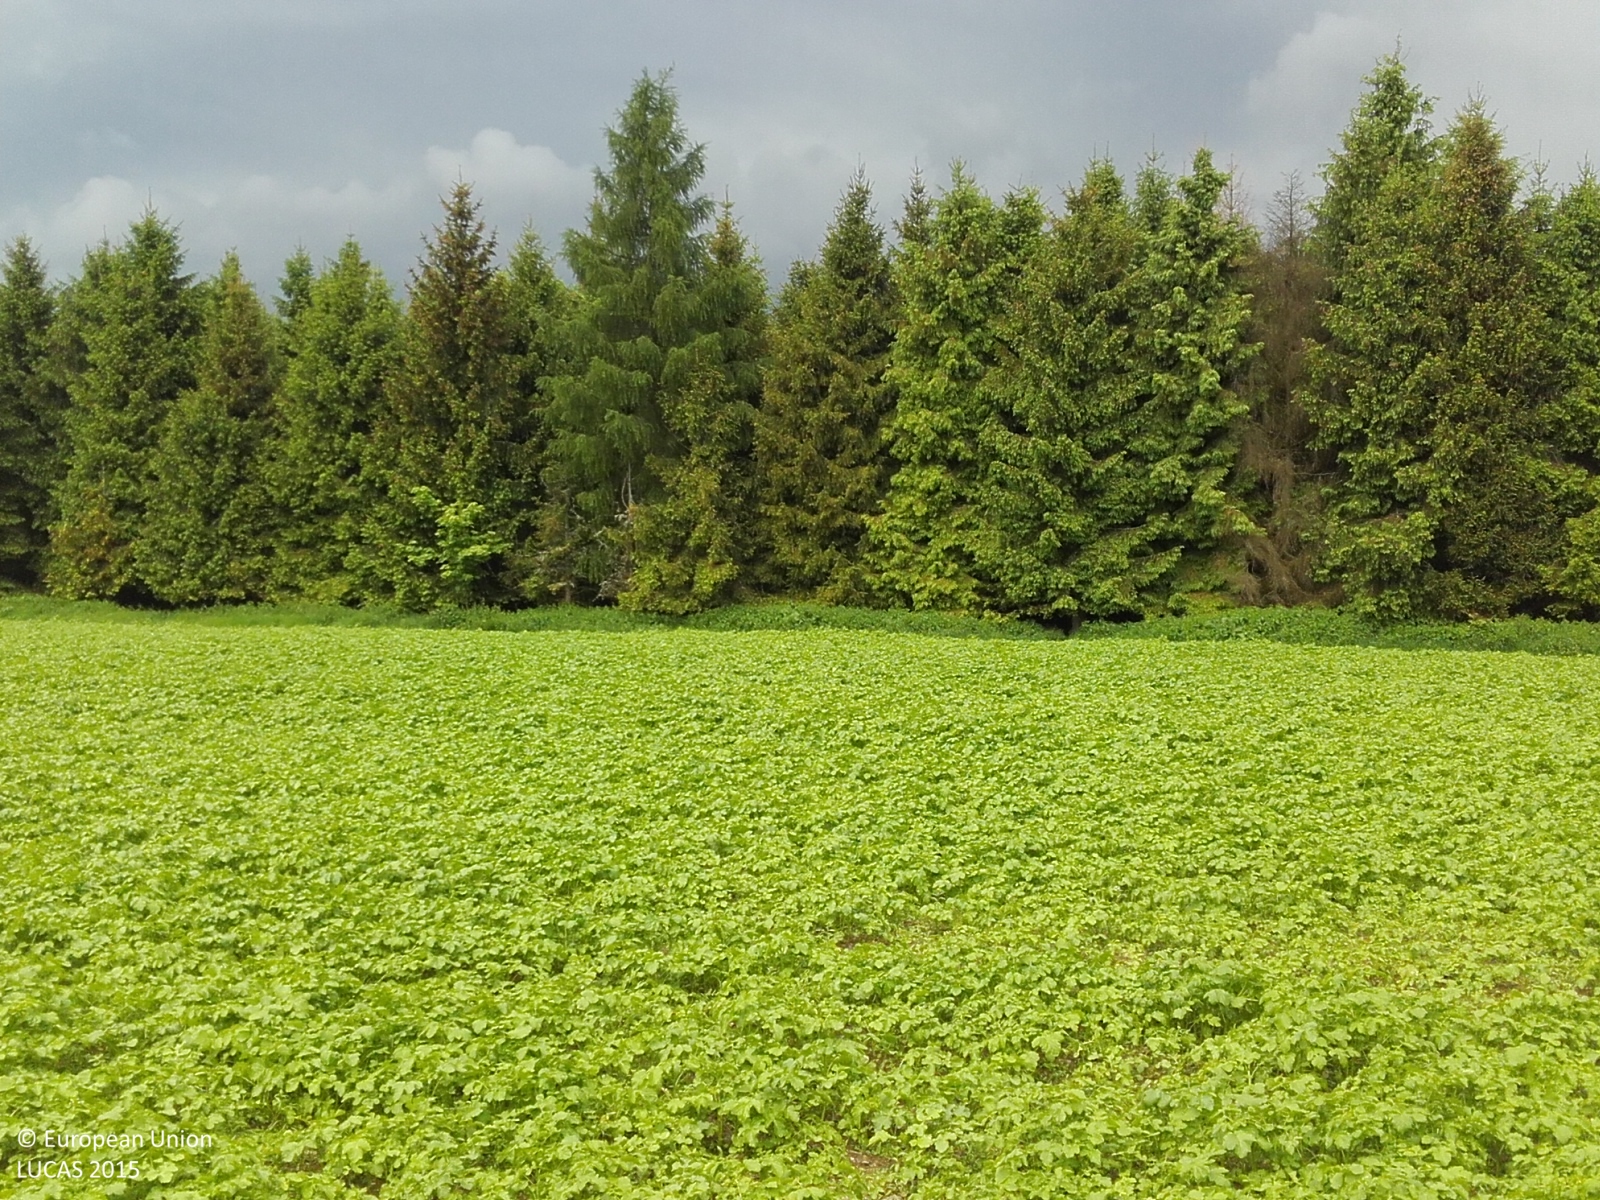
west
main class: Cropland
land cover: Rape and turnip rape
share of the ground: > 75 %
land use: Agriculture (excluding fallow land and kitchen gardens)
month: May
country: CZ
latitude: 49.8492
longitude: 17.7323
